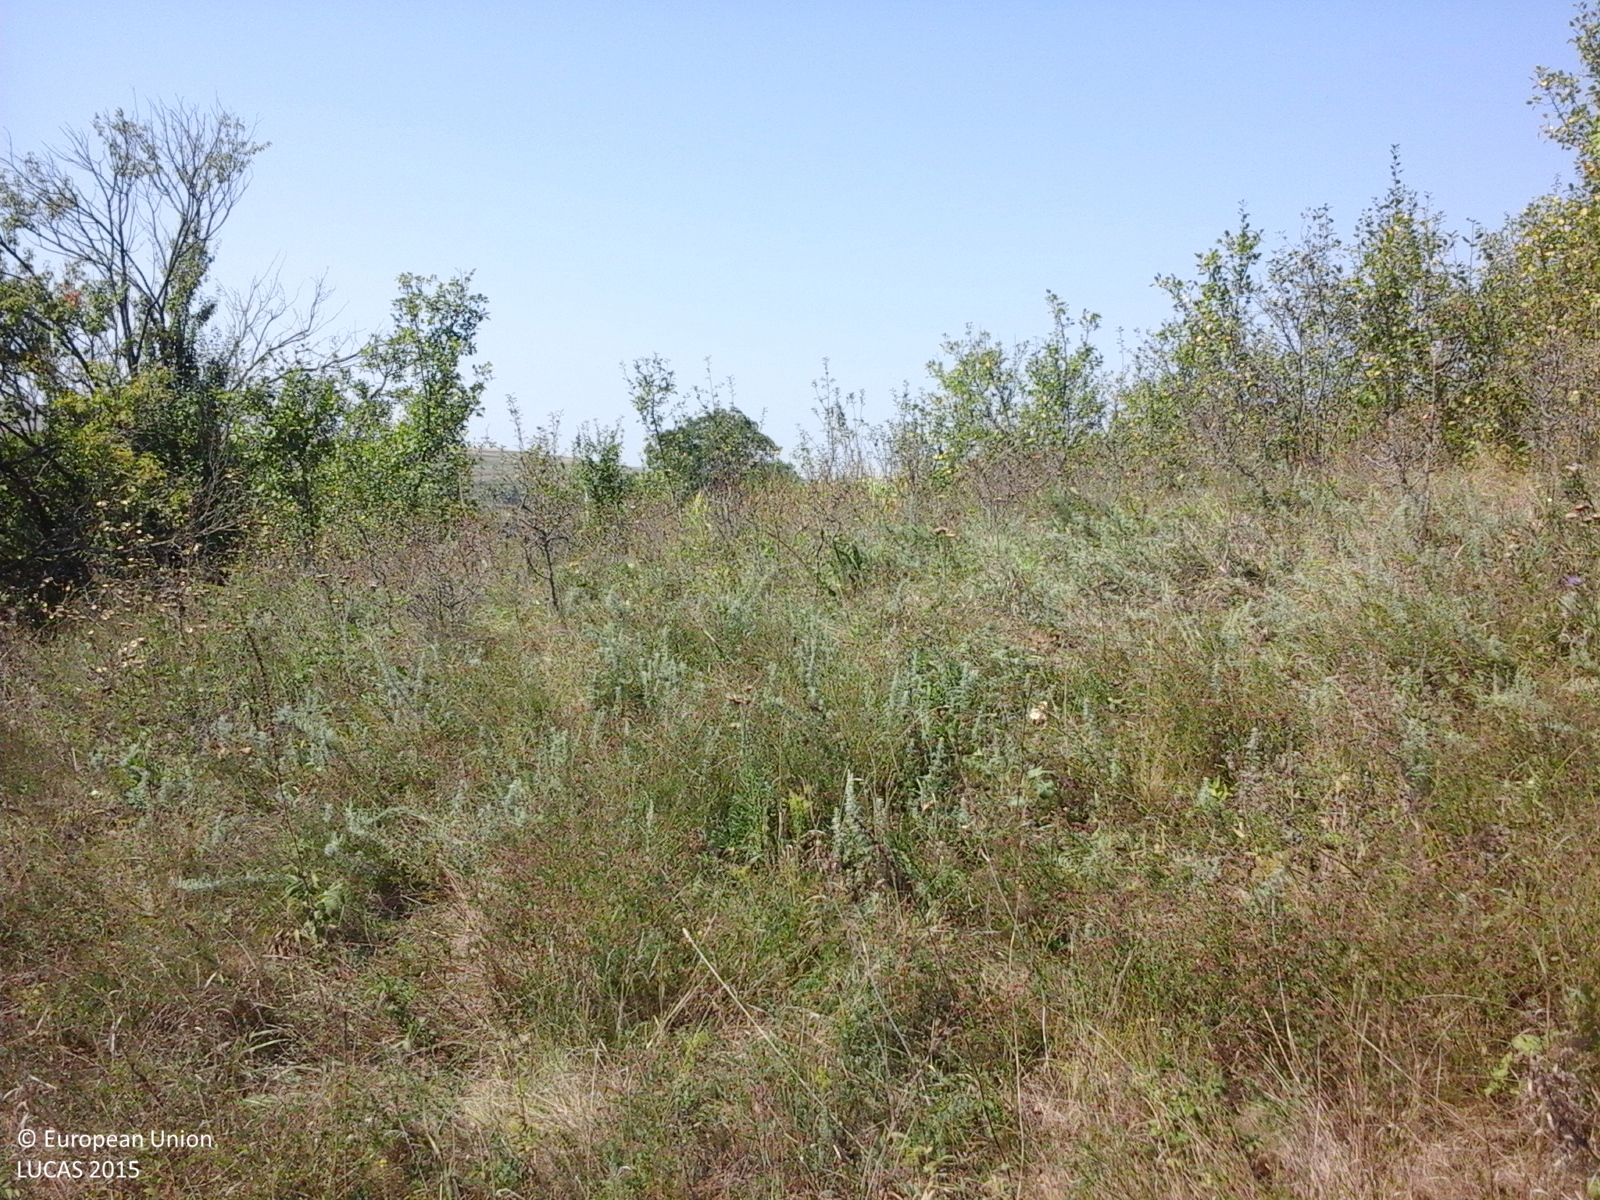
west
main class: Grassland
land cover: Grassland with sparse tree/shrub cover
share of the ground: > 75 %
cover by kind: herbaceous plants 95 %, broadleaved forest trees 5 %
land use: Agriculture (excluding fallow land and kitchen gardens)
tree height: < 5 m
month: September
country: RO
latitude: 46.7604
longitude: 24.3969
